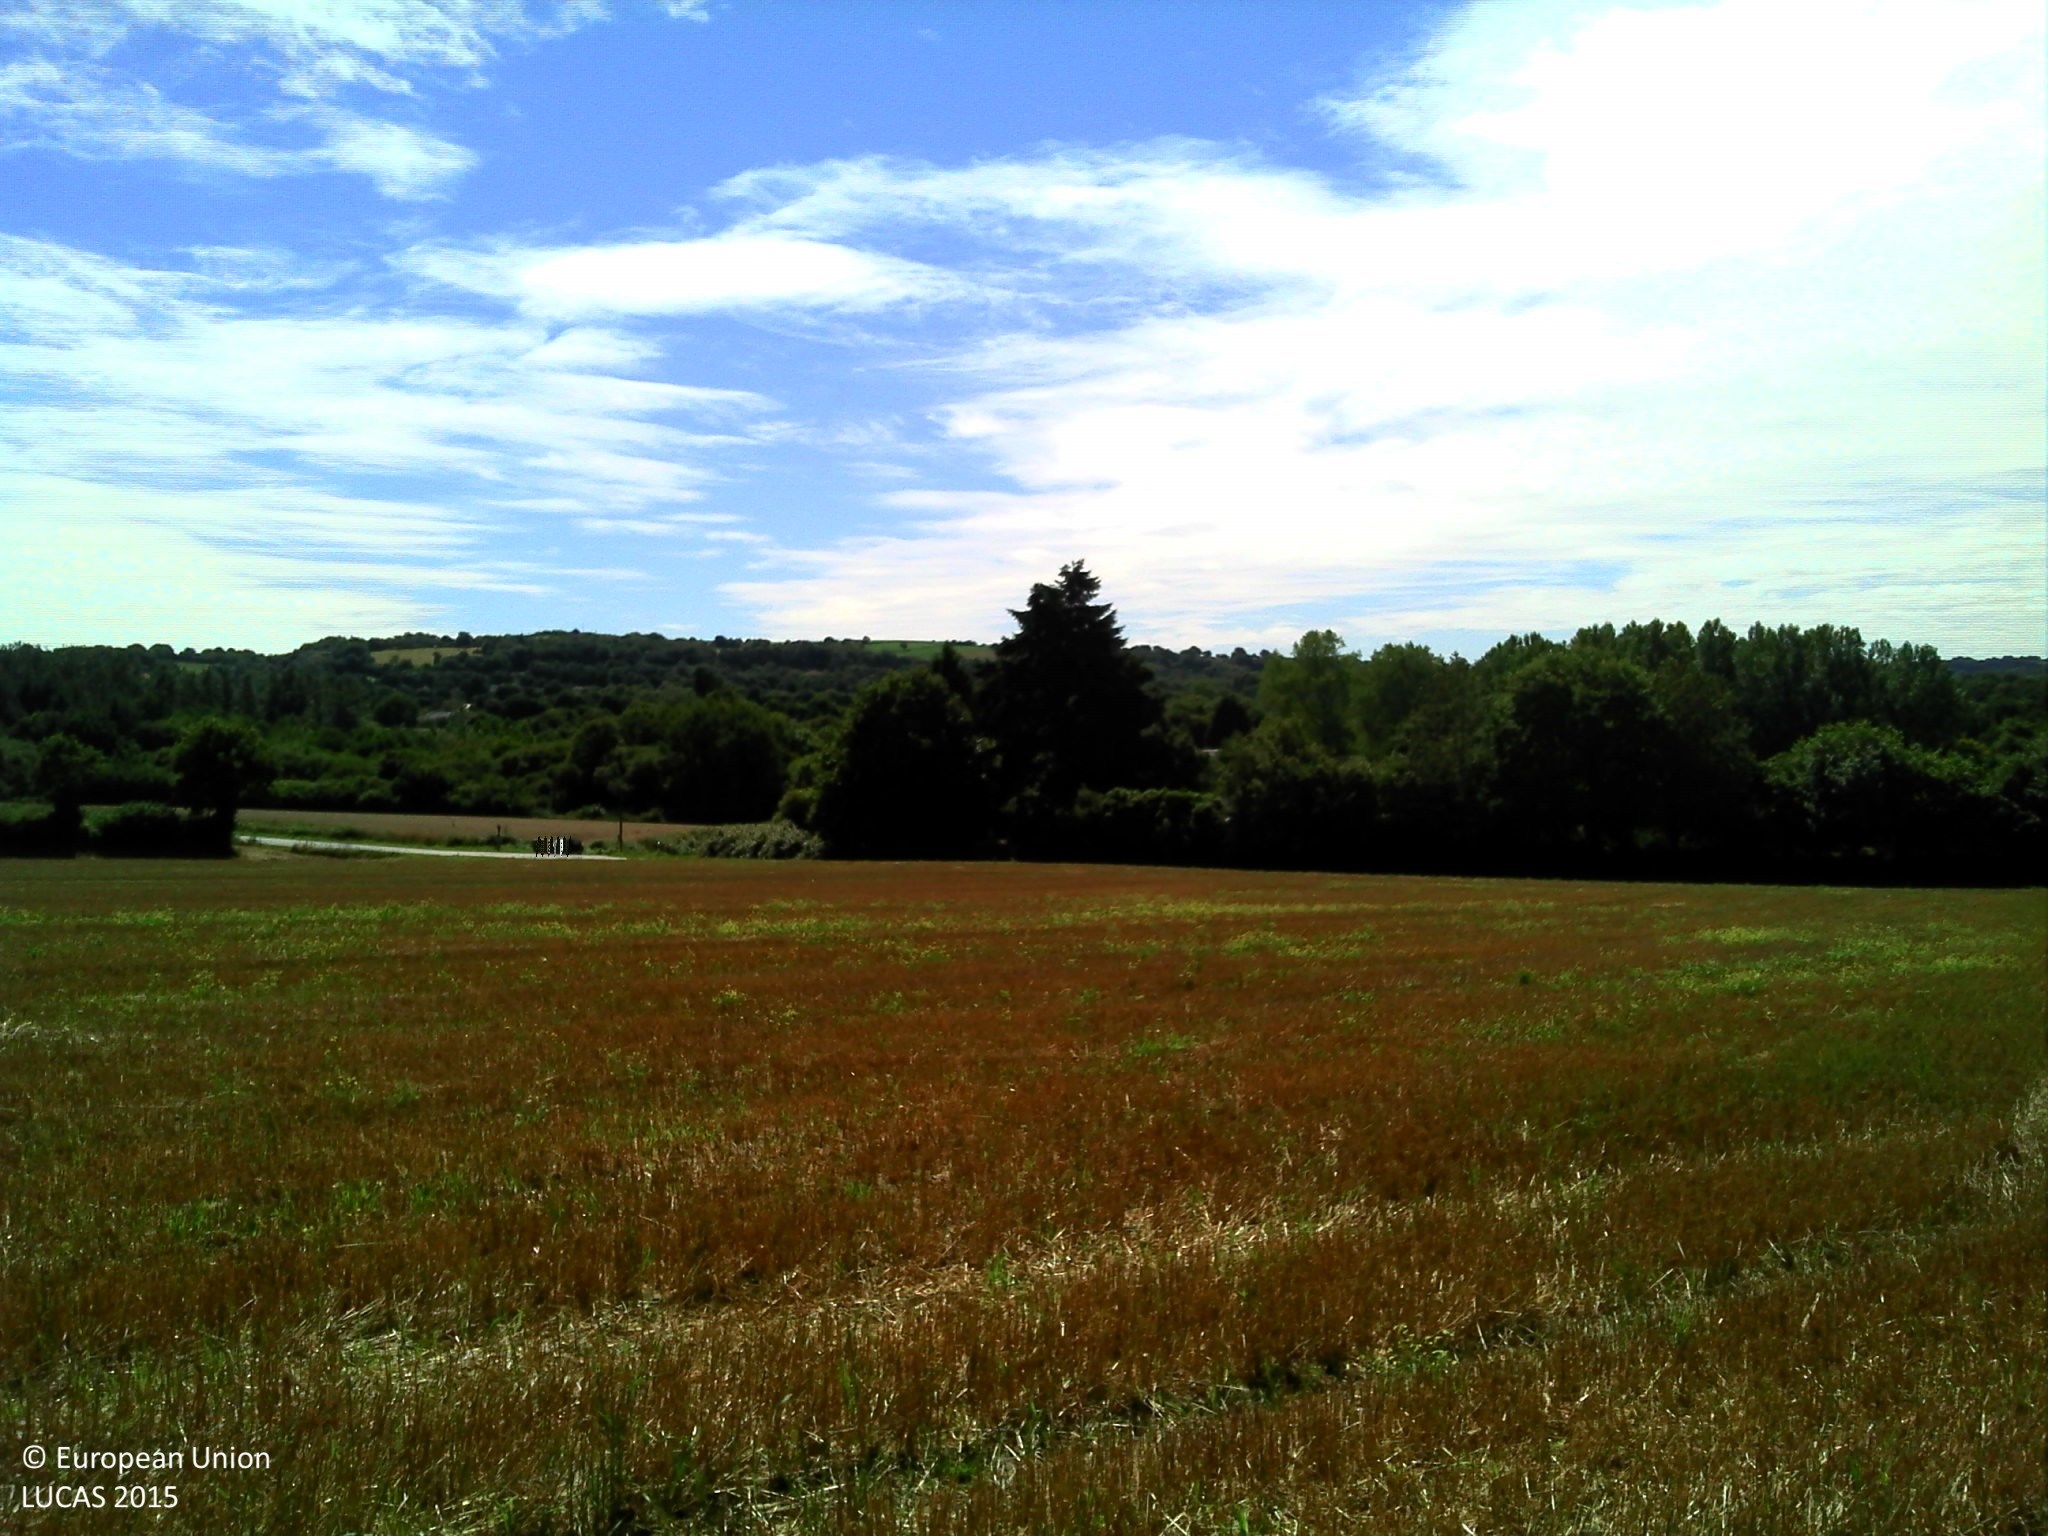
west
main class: Cropland
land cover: Barley
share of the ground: > 75 %
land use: Agriculture (excluding fallow land and kitchen gardens)
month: August
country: FR
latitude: 48.4800
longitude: -3.3750
